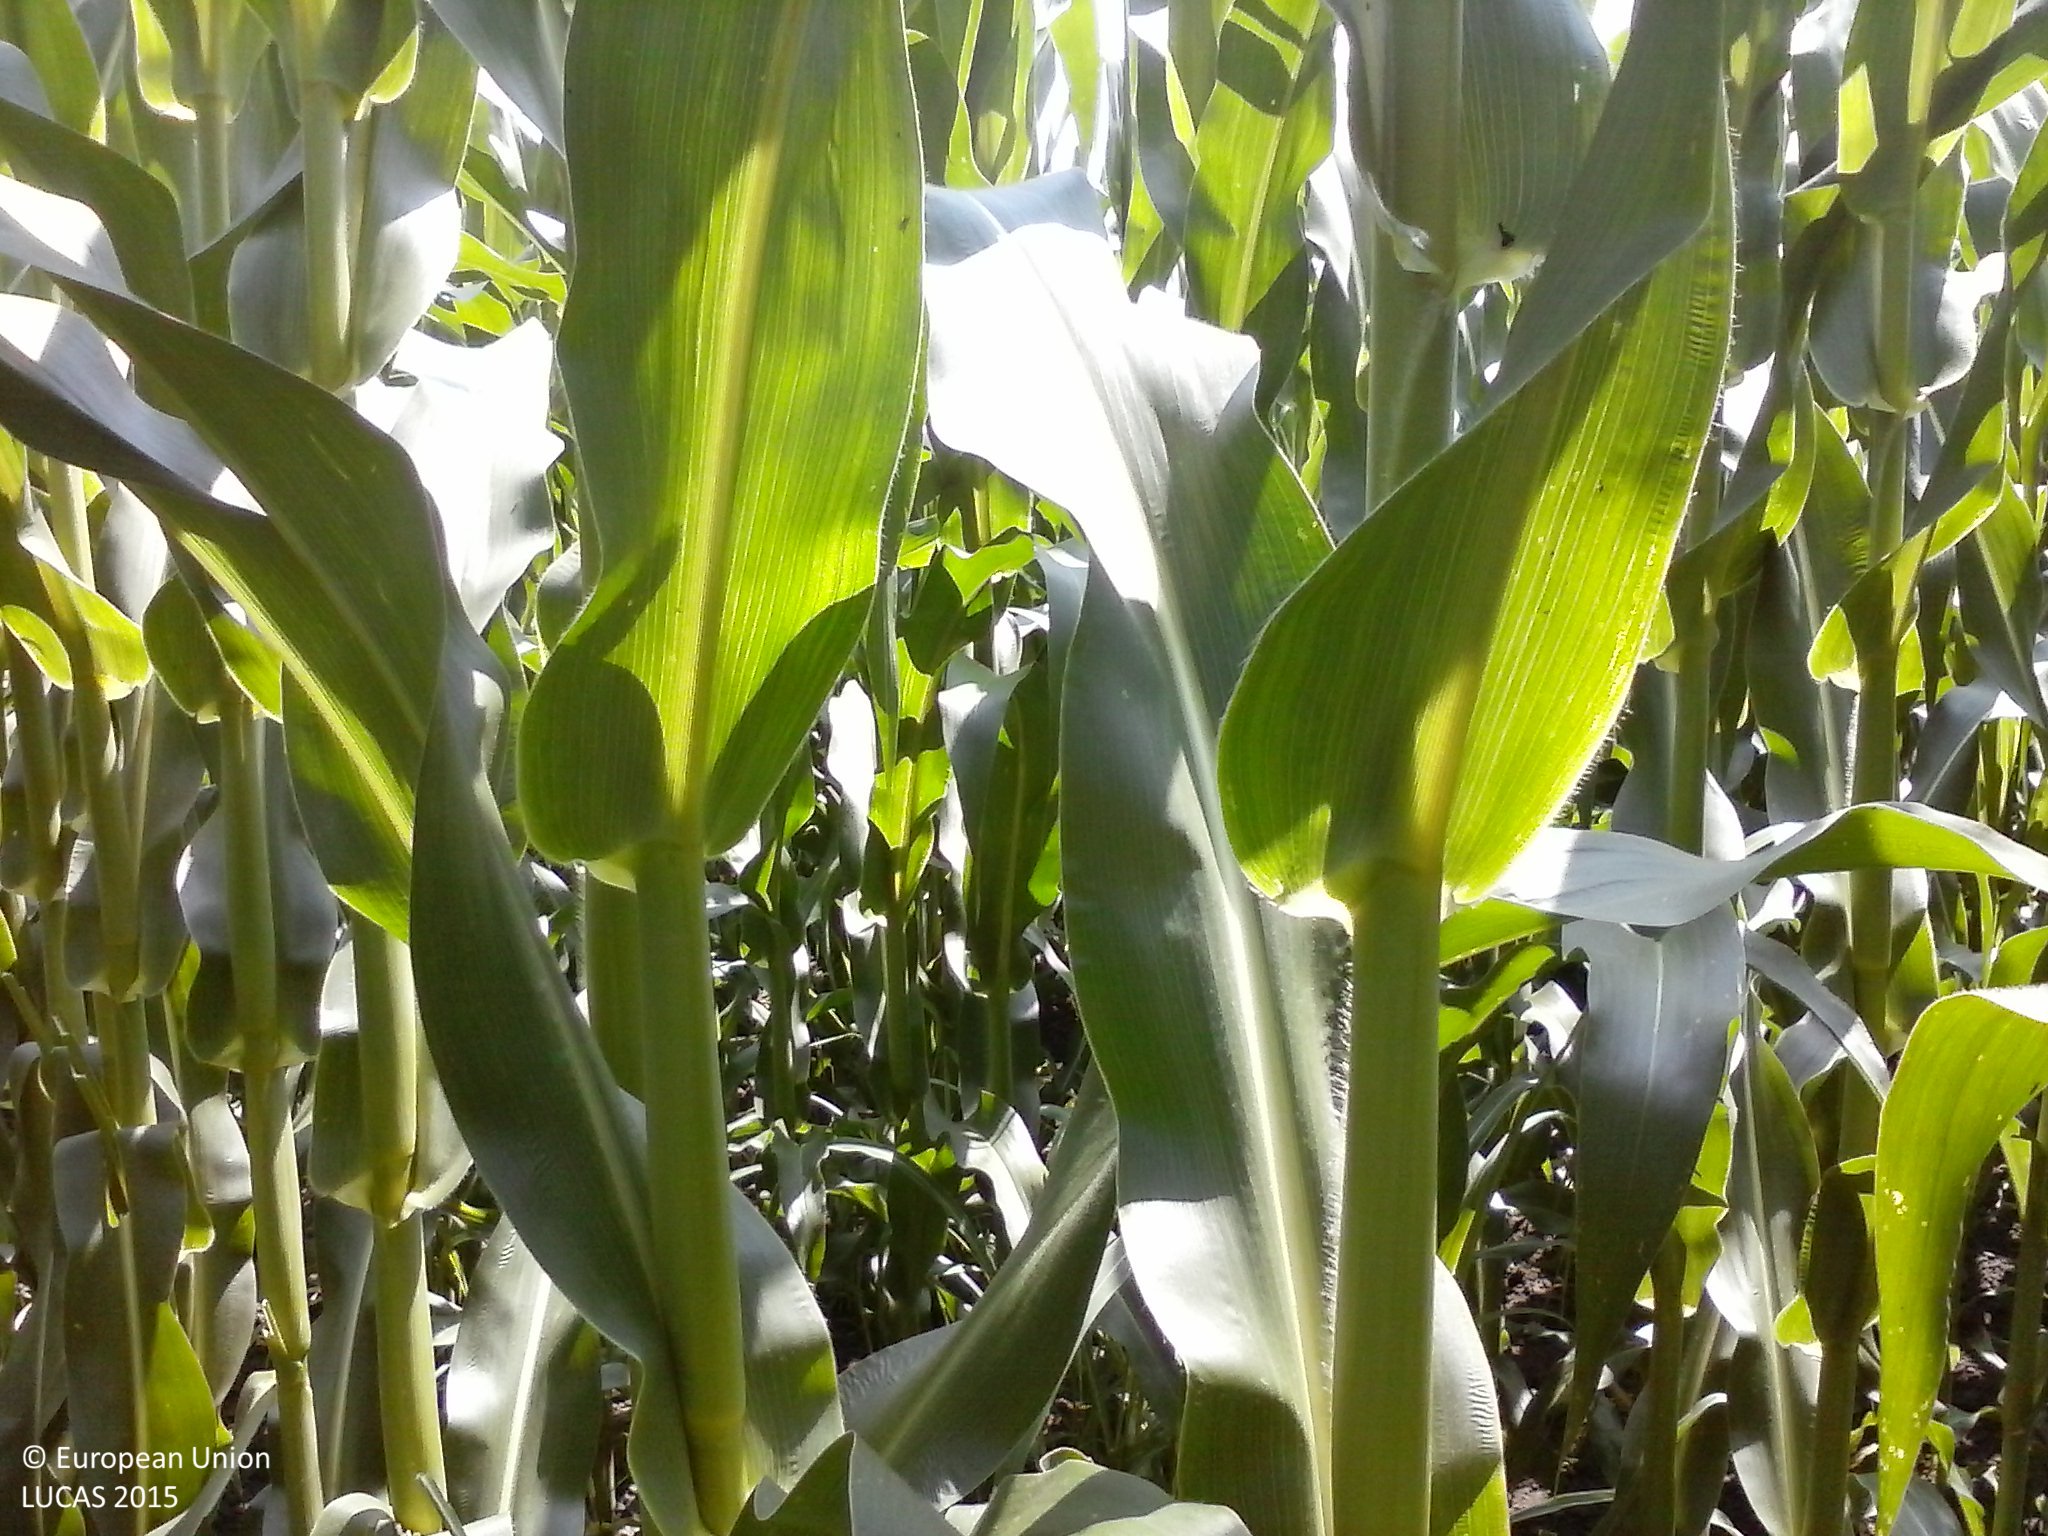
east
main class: Cropland
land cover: Maize
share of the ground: > 75 %
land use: Agriculture (excluding fallow land and kitchen gardens)
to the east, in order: Maize; Grass margins; Ditches and canals; Grass margins; Maize
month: June
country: HU
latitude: 46.2183
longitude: 19.4925
